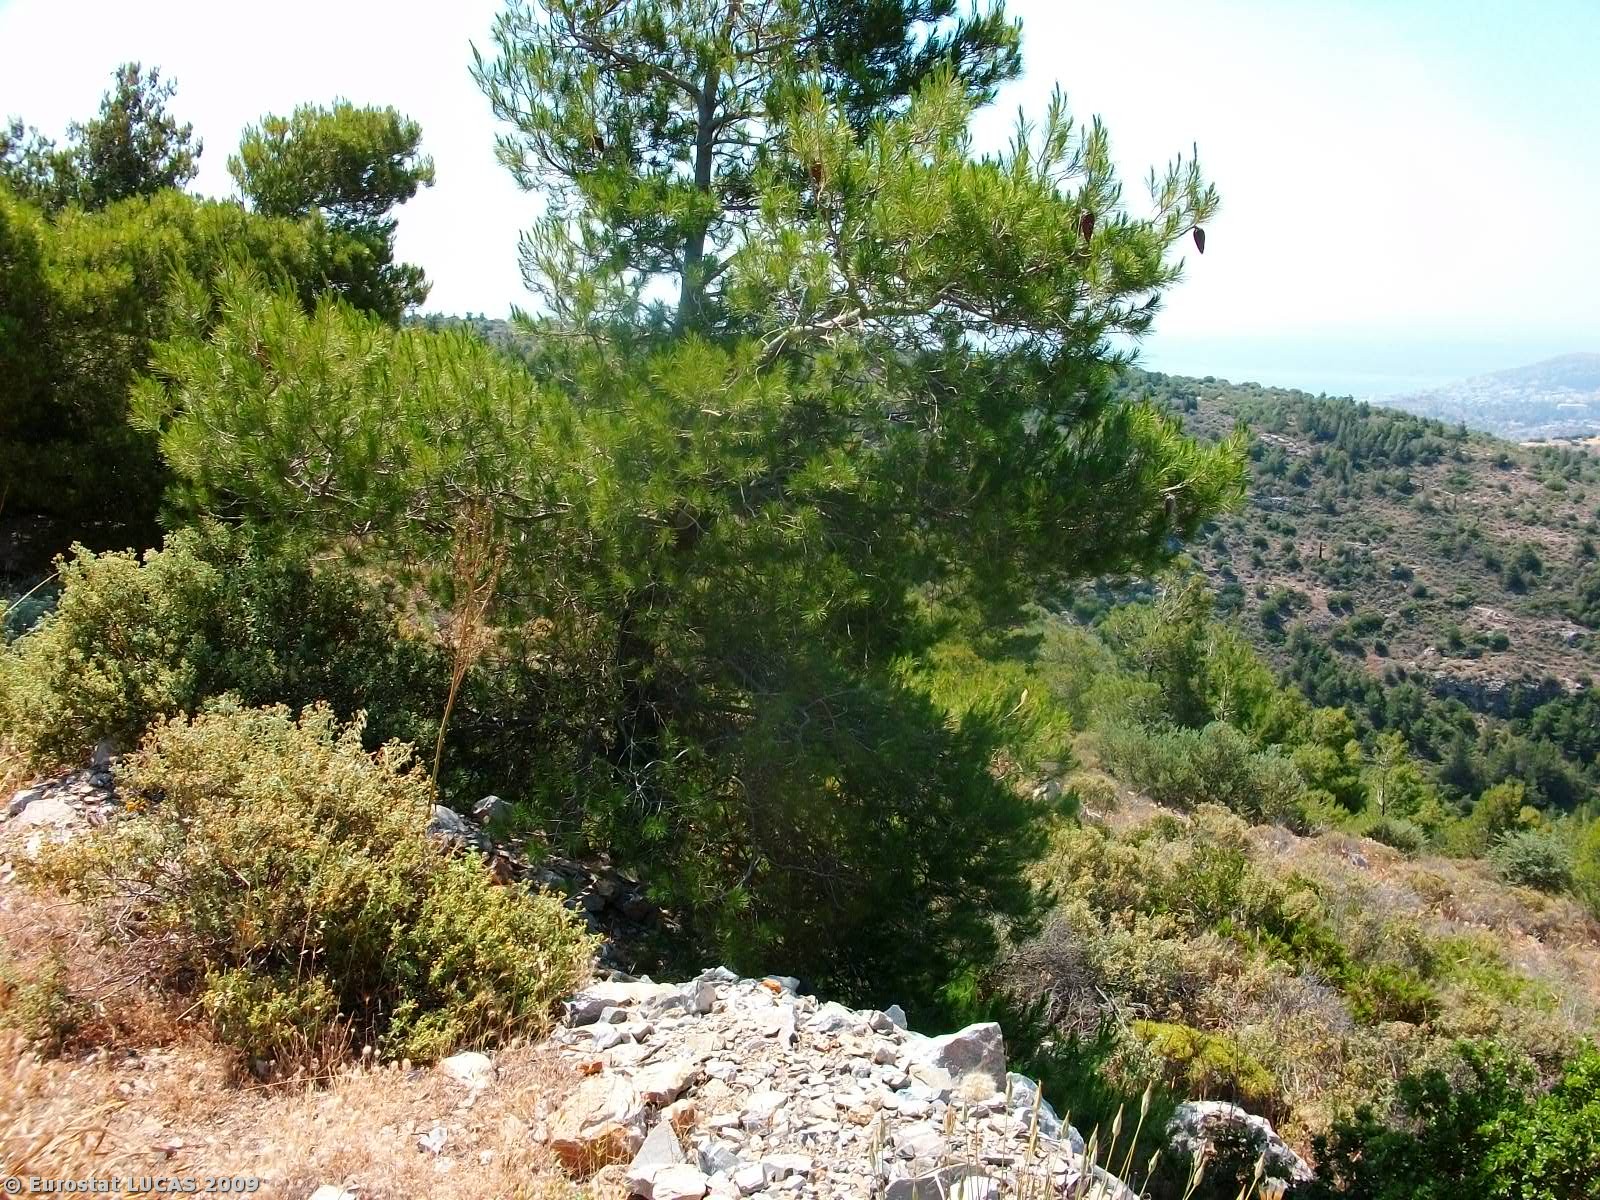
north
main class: Woodland
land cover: Coniferous woodland
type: coniferous forest of the mediterranean region
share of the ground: 50 - 75 %
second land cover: Grassland with sparse tree/shrub cover
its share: 10 - 25 %
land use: Forestry
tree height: > 5 m
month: May
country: GR
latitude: 37.8579
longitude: 23.7890
